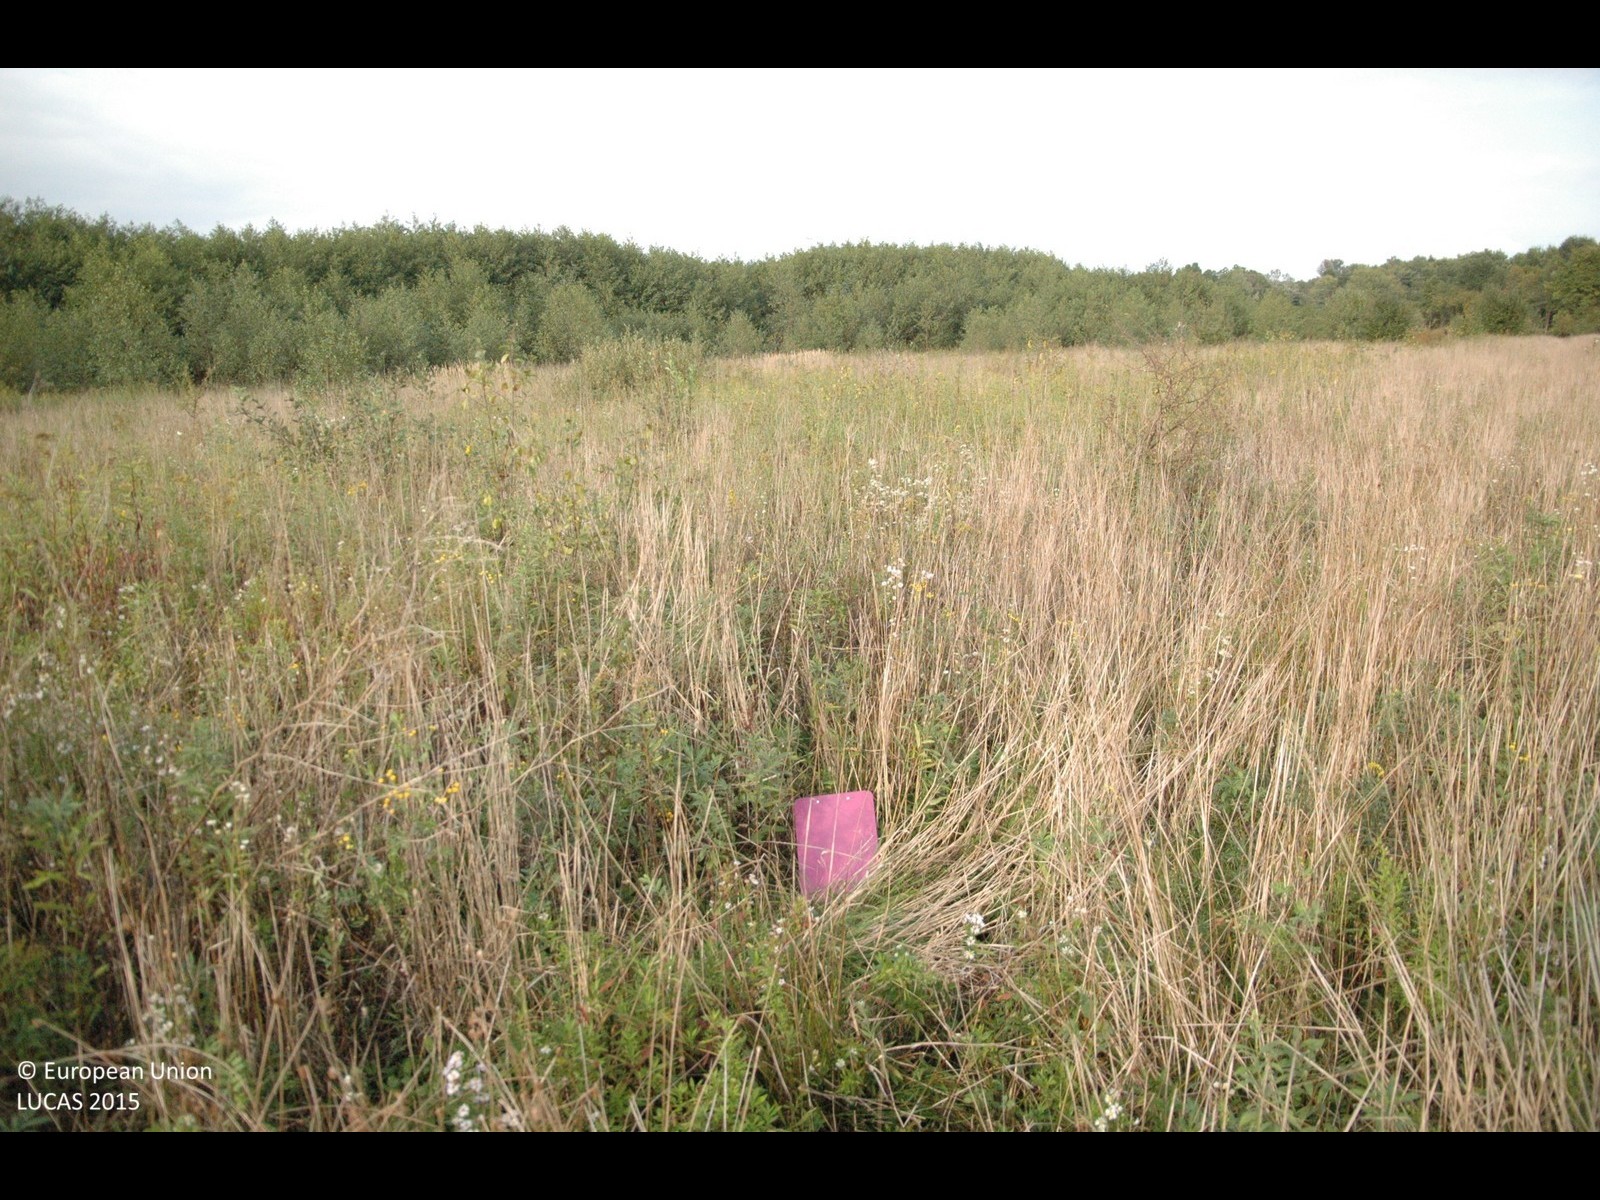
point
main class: Grassland
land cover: Grassland without tree/shrub cover
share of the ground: > 75 %
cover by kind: herbaceous plants 100 %
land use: Agriculture (excluding fallow land and kitchen gardens)
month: October
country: HR
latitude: 45.5549
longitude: 16.2362
